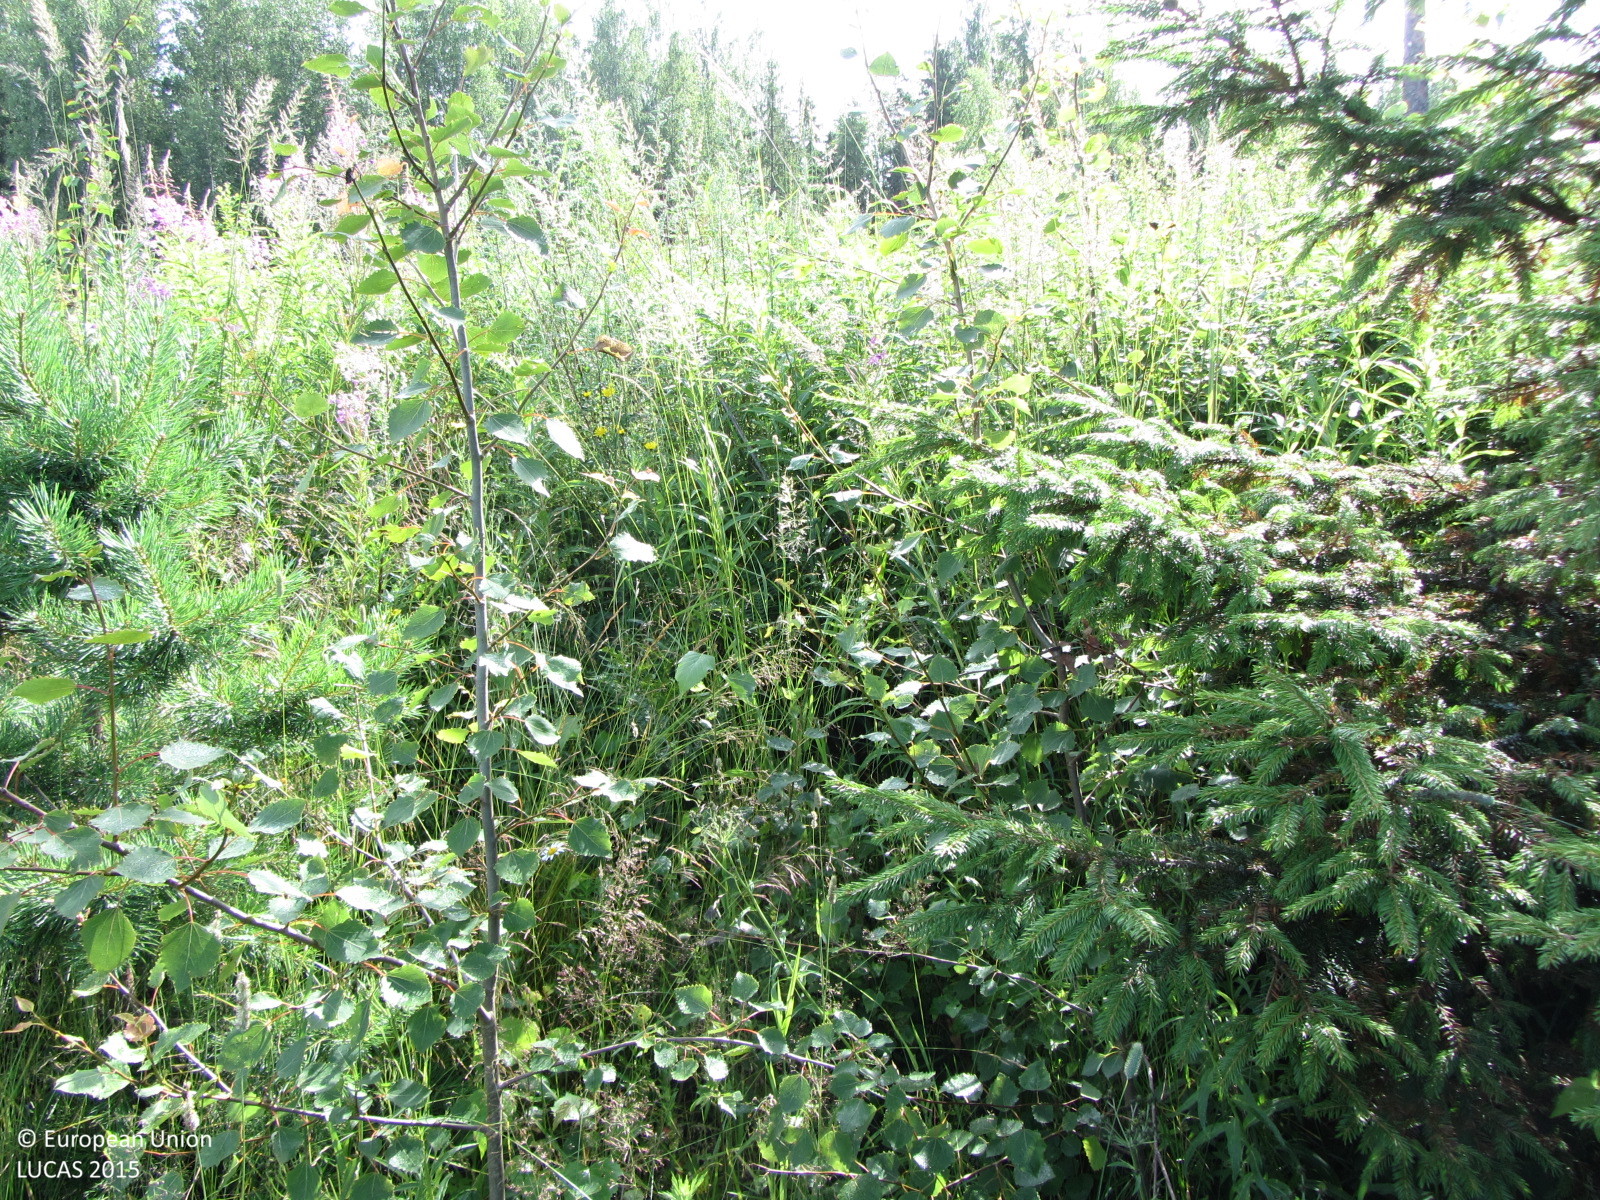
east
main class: Cropland
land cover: Barley
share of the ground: > 75 %
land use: Agriculture (excluding fallow land and kitchen gardens)
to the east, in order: Barley; Electric lines; Barley; Grass margins; Ditches and canals; Spontaneously vegetated surfaces; Paved roads, cycling and walking lanes; Ditches and canals; Tracks; Spruce dominated mixed woodland
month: July
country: FI
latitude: 60.7921
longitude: 24.6010
